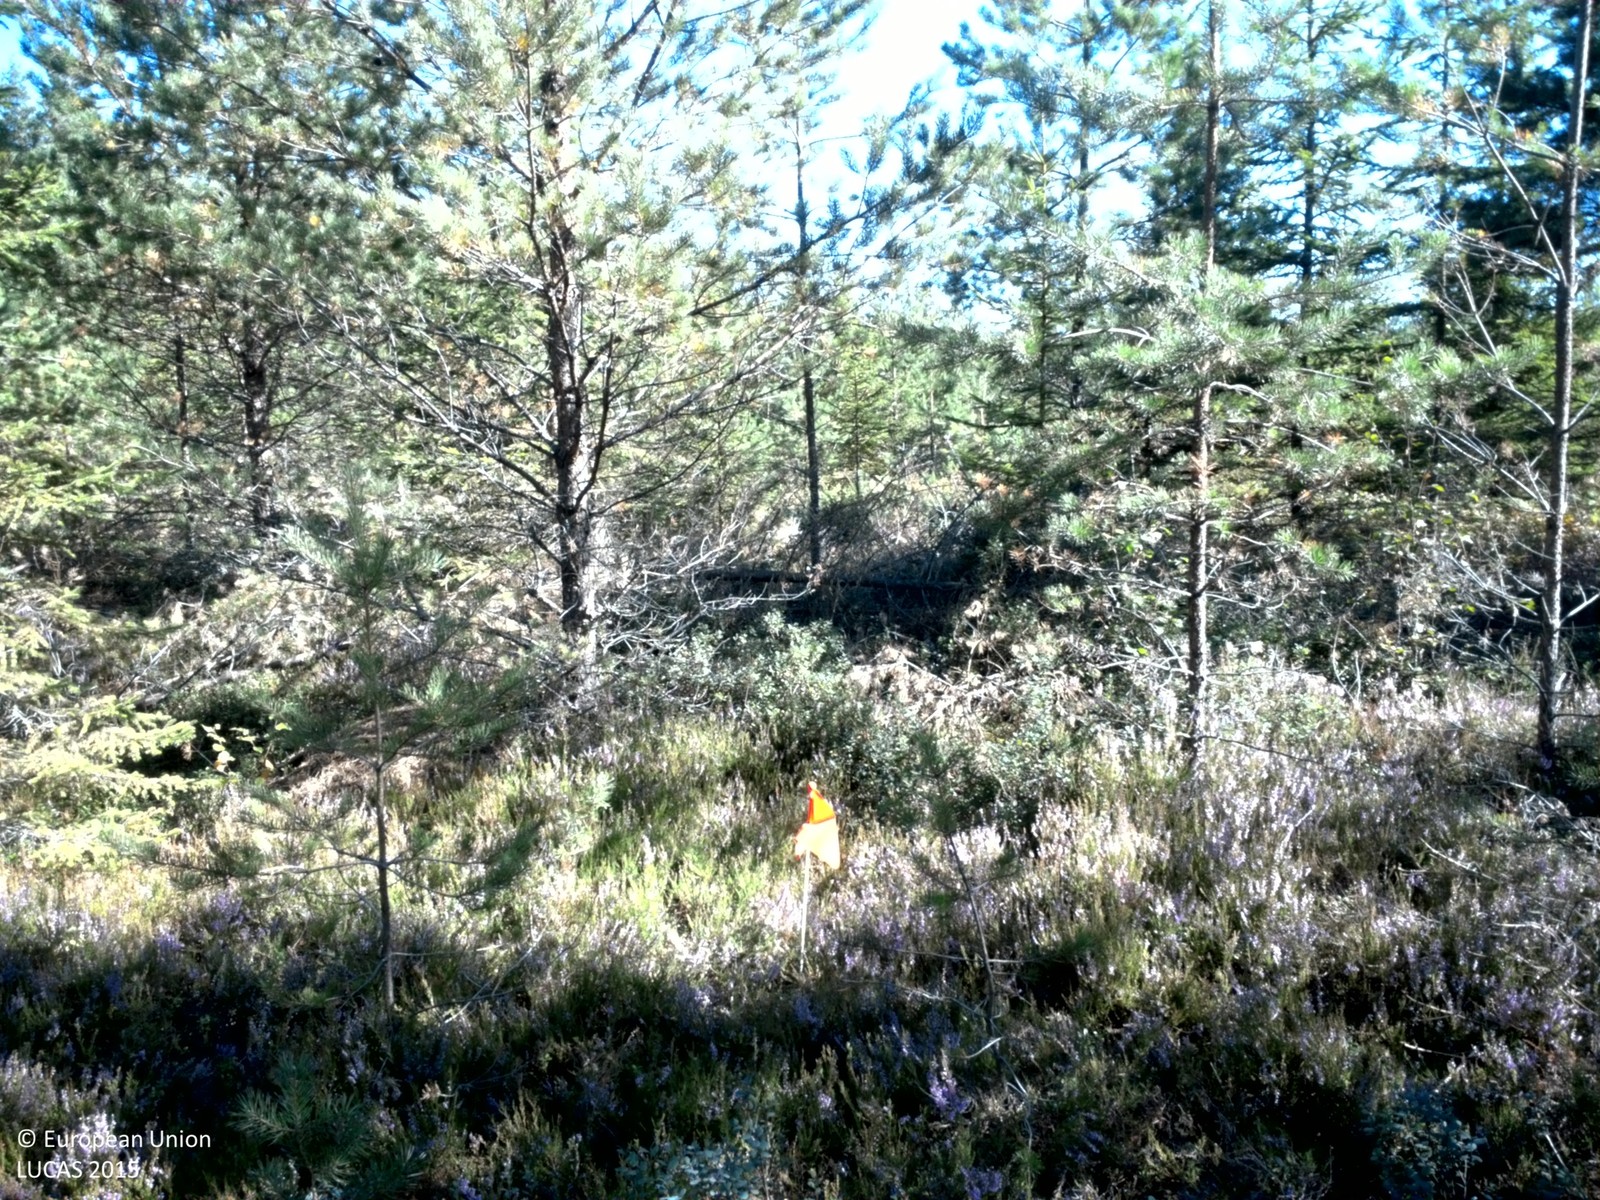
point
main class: Woodland
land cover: Pine dominated coniferous woodland
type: boreal forest
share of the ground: 50 - 75 %
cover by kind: coniferous forest trees 65 %, shrubs 30 %, herbaceous plants 5 %
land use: Forestry
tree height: < 5 m
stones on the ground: < 10 %
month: August
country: SE
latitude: 59.6227
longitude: 15.9302
